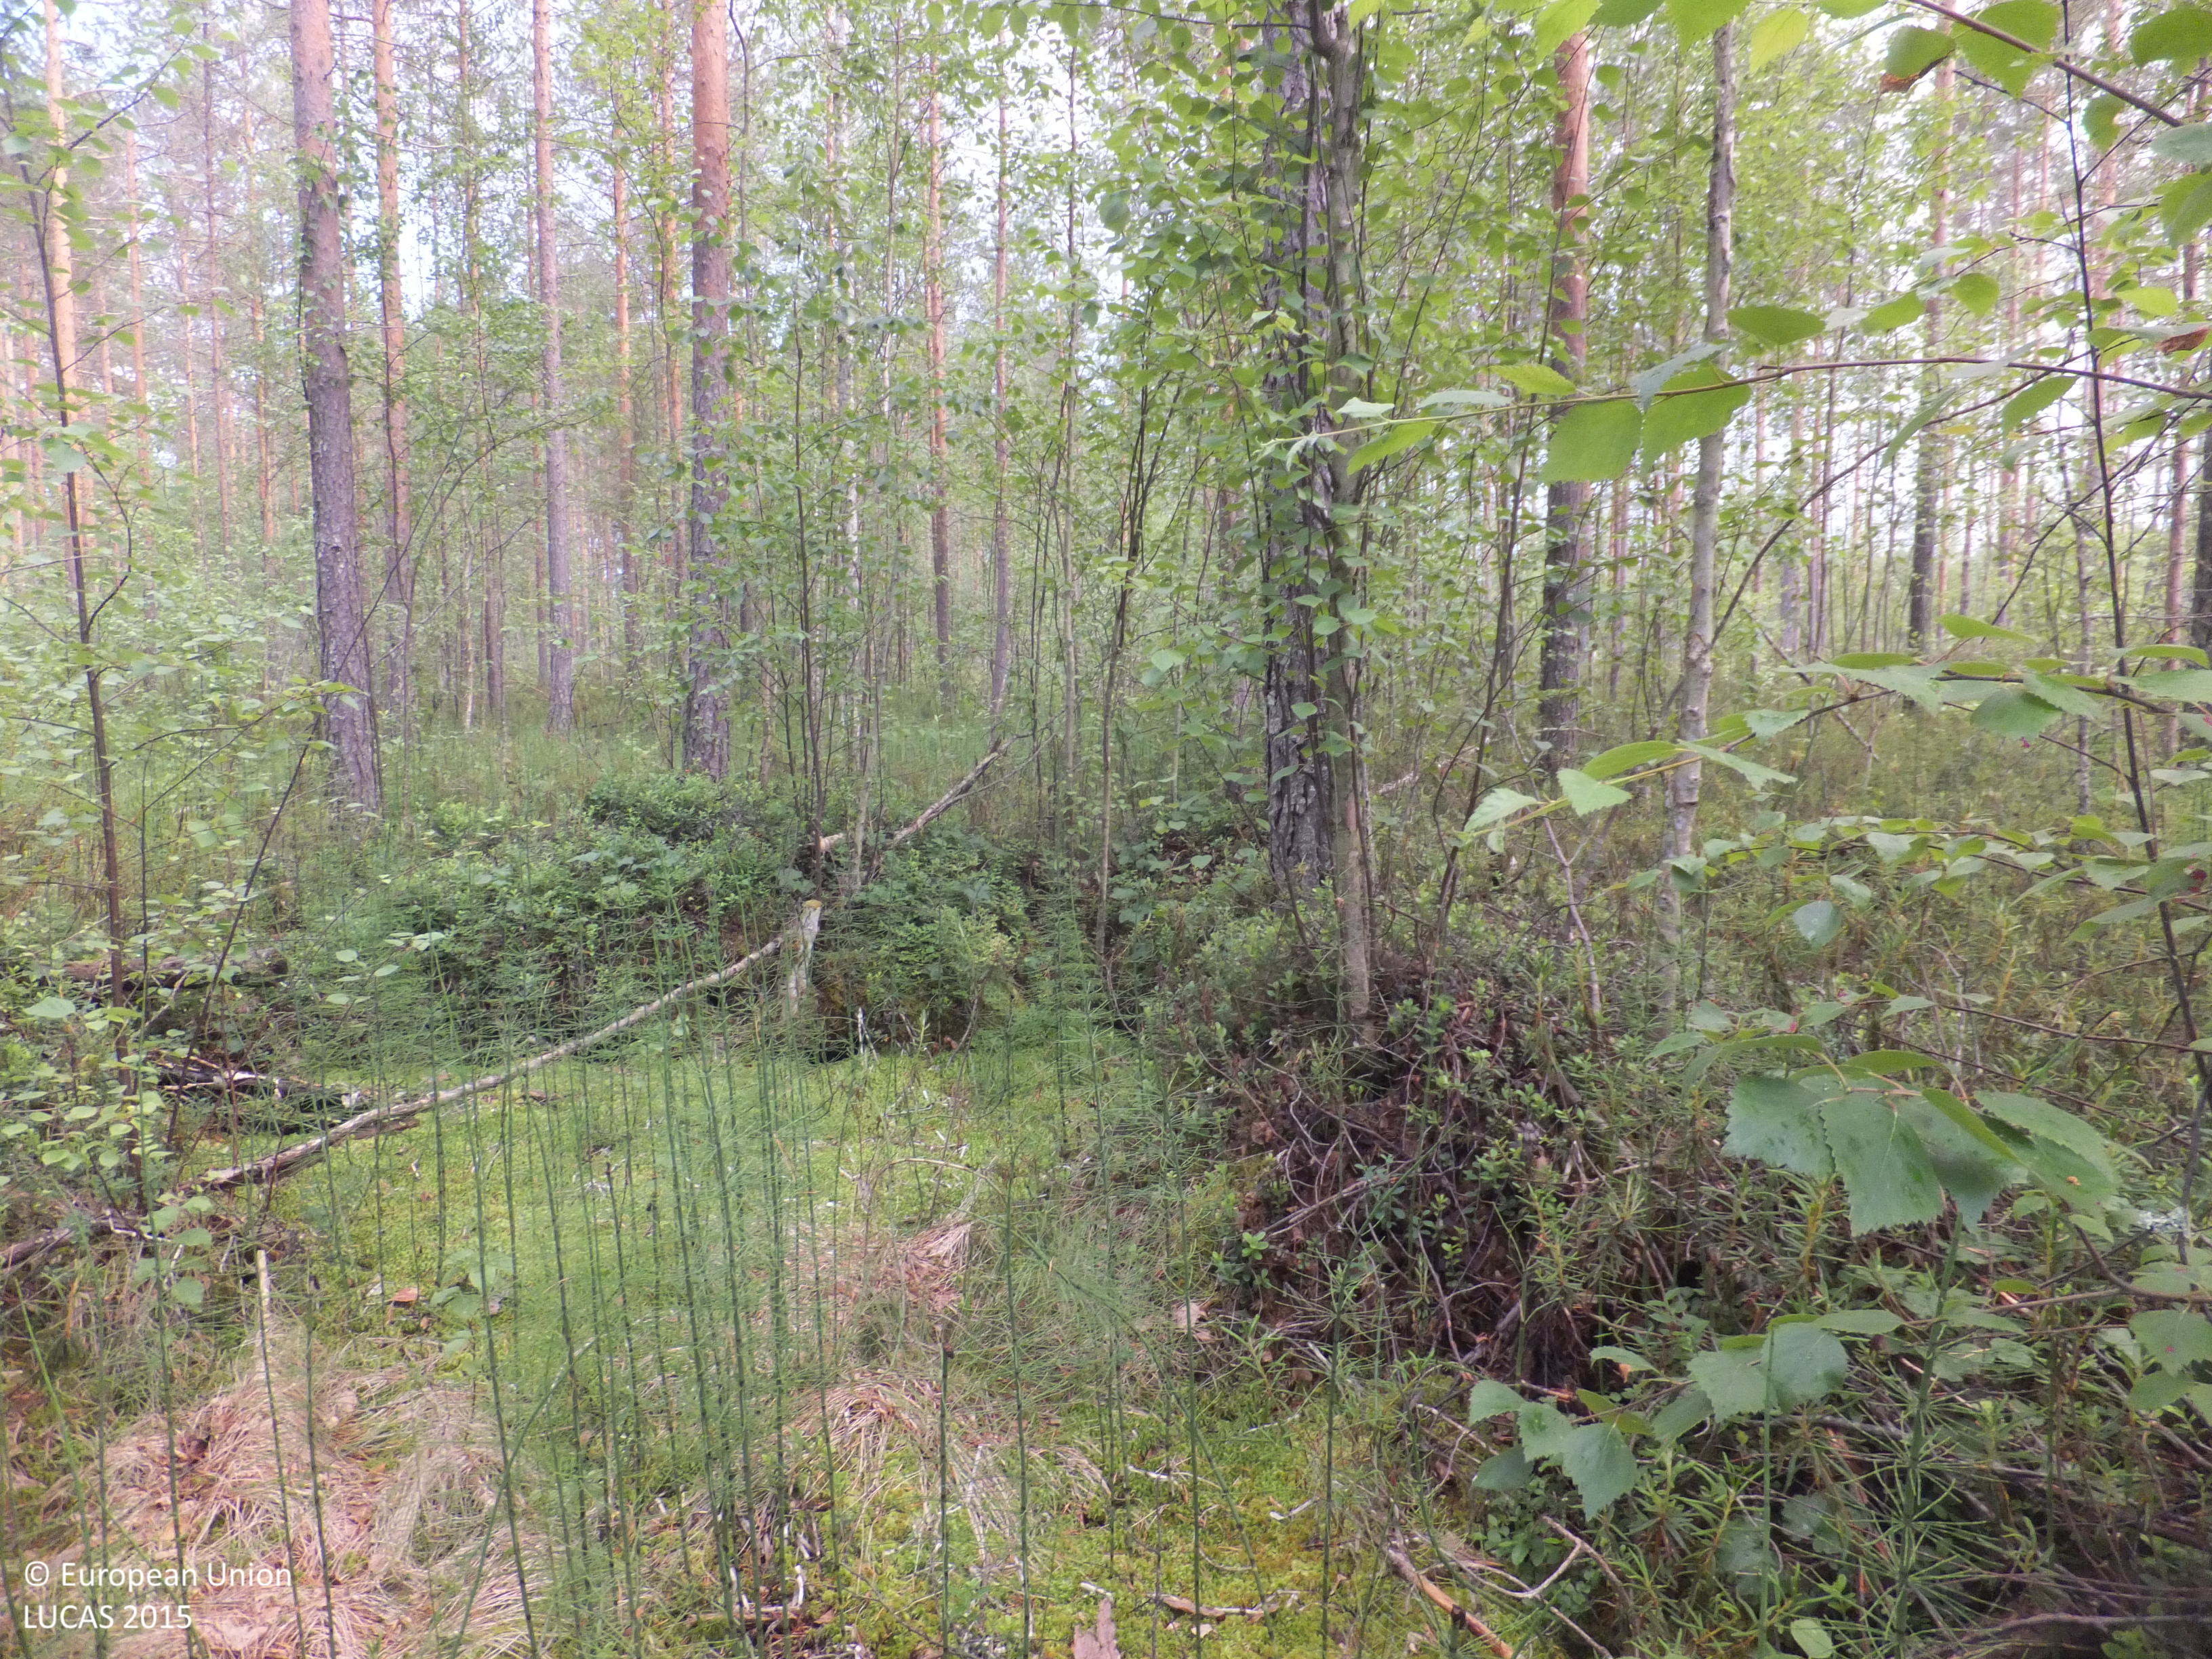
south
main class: Woodland
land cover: Pine dominated mixed woodland
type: boreal forest
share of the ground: > 75 %
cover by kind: coniferous forest trees 40 %, broadleaved forest trees 40 %, shrubs 10 %, herbaceous plants 5 %, lichens and mosses 5 %
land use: Forestry
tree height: > 5 m
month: July
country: FI
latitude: 63.0810
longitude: 24.5176
